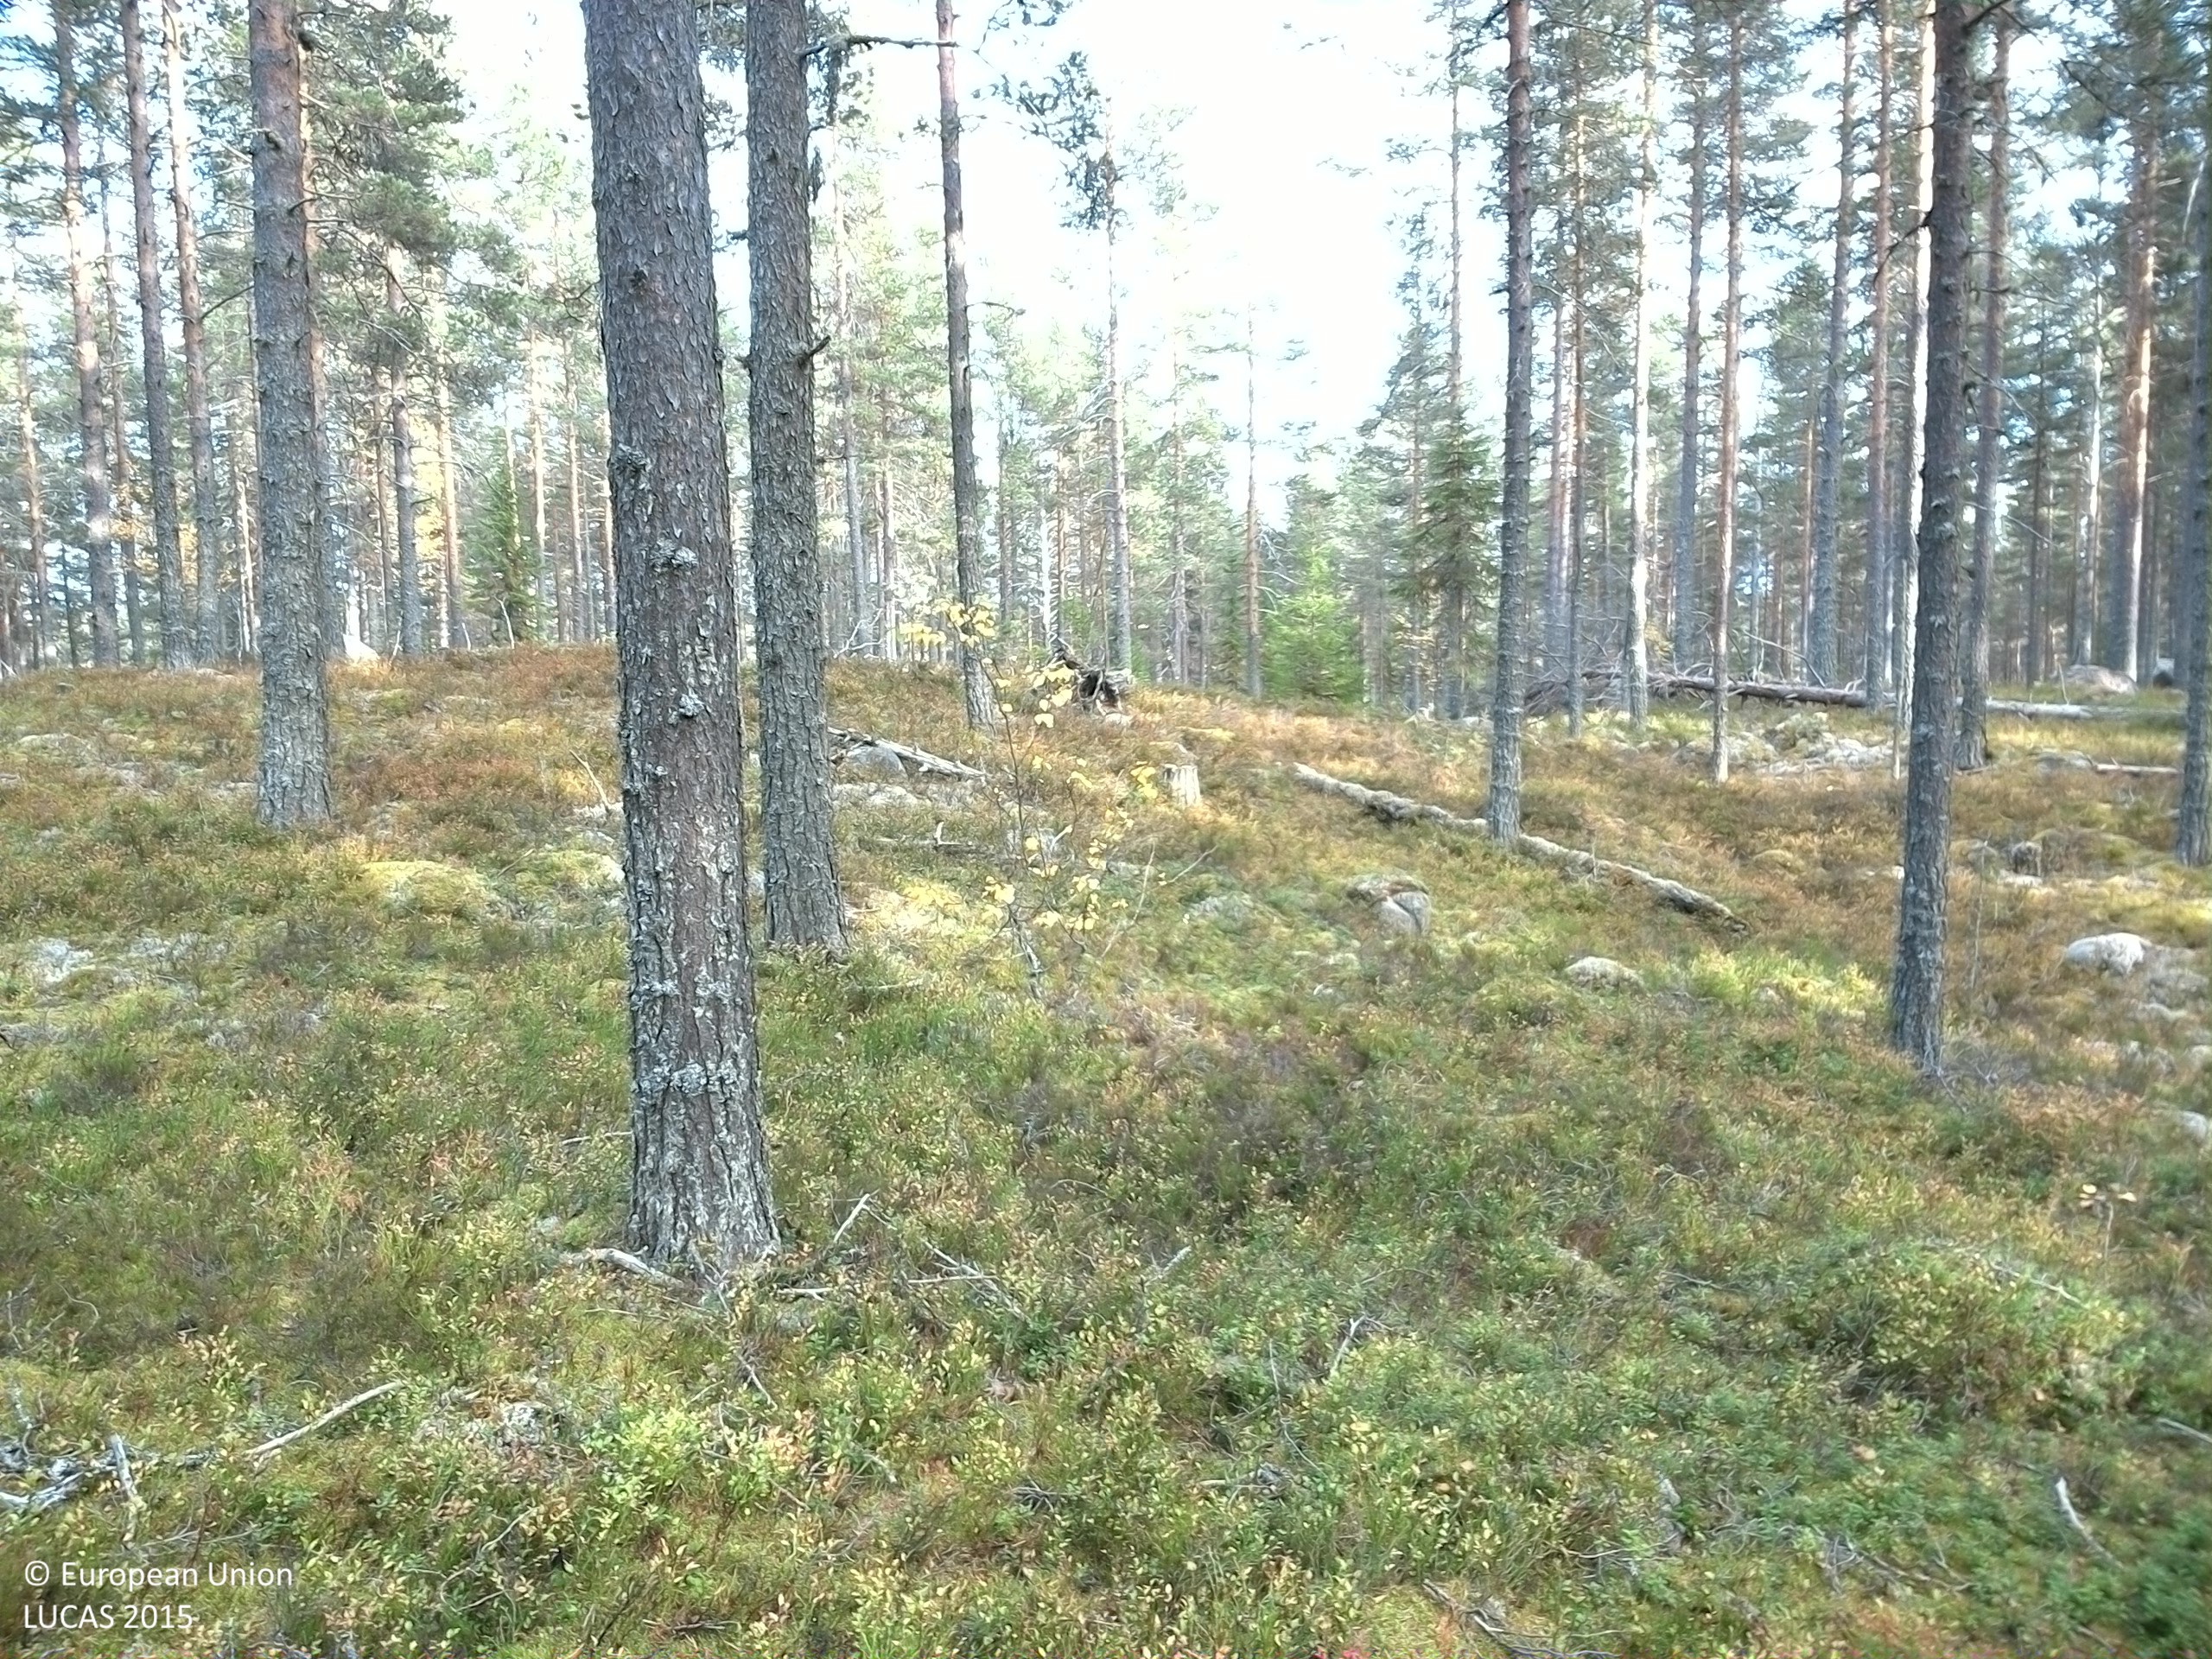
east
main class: Woodland
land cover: Pine dominated coniferous woodland
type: boreal forest
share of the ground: 50 - 75 %
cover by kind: coniferous forest trees 50 %, shrubs 25 %, lichens and mosses 15 %, consolidated bare surface 10 %
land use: Forestry
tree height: > 5 m
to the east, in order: Pine dominated coniferous woodland; Spruce dominated mixed woodland; Paved roads, cycling and walking lanes; Other coniferous woodland; Pine dominated coniferous woodland; Other mixed woodland
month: October
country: SE
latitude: 61.2830
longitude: 15.0039
